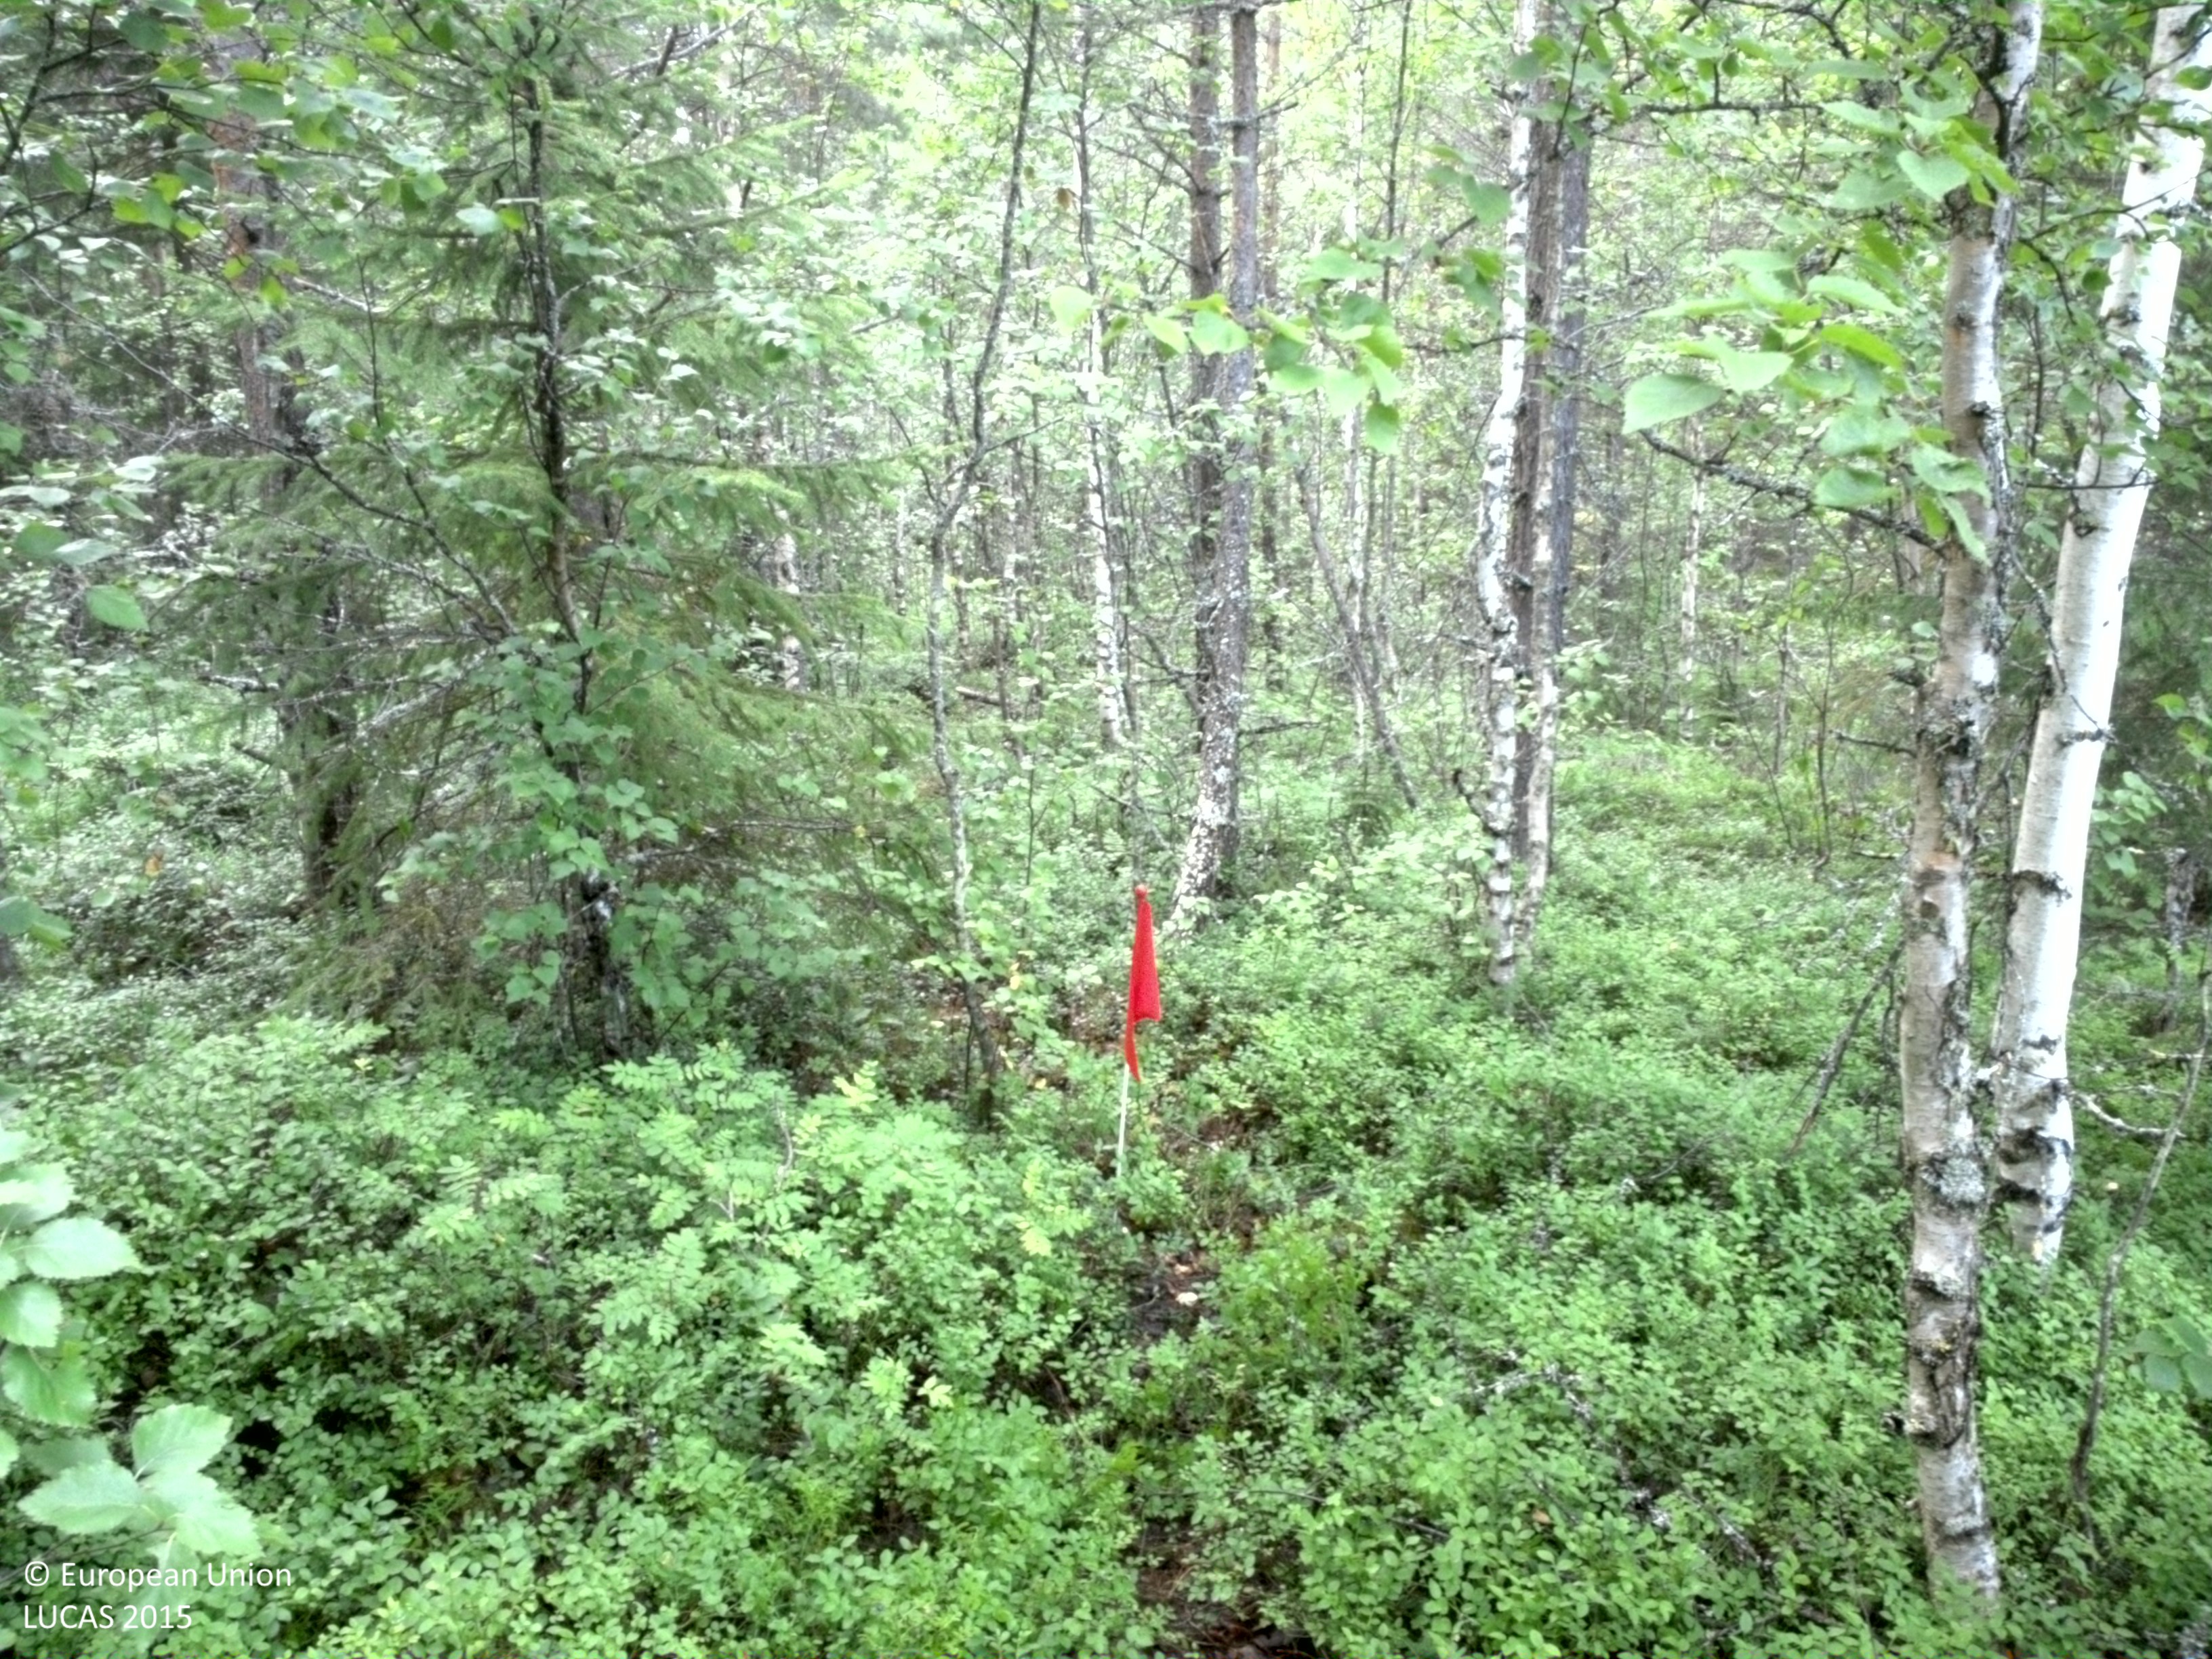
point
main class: Woodland
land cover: Other mixed woodland
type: boreal forest
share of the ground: 50 - 75 %
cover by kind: coniferous forest trees 45 %, broadleaved forest trees 30 %, shrubs 20 %, lichens and mosses 5 %
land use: Forestry
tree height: > 5 m
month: August
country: SE
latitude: 64.6402
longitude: 20.6700
